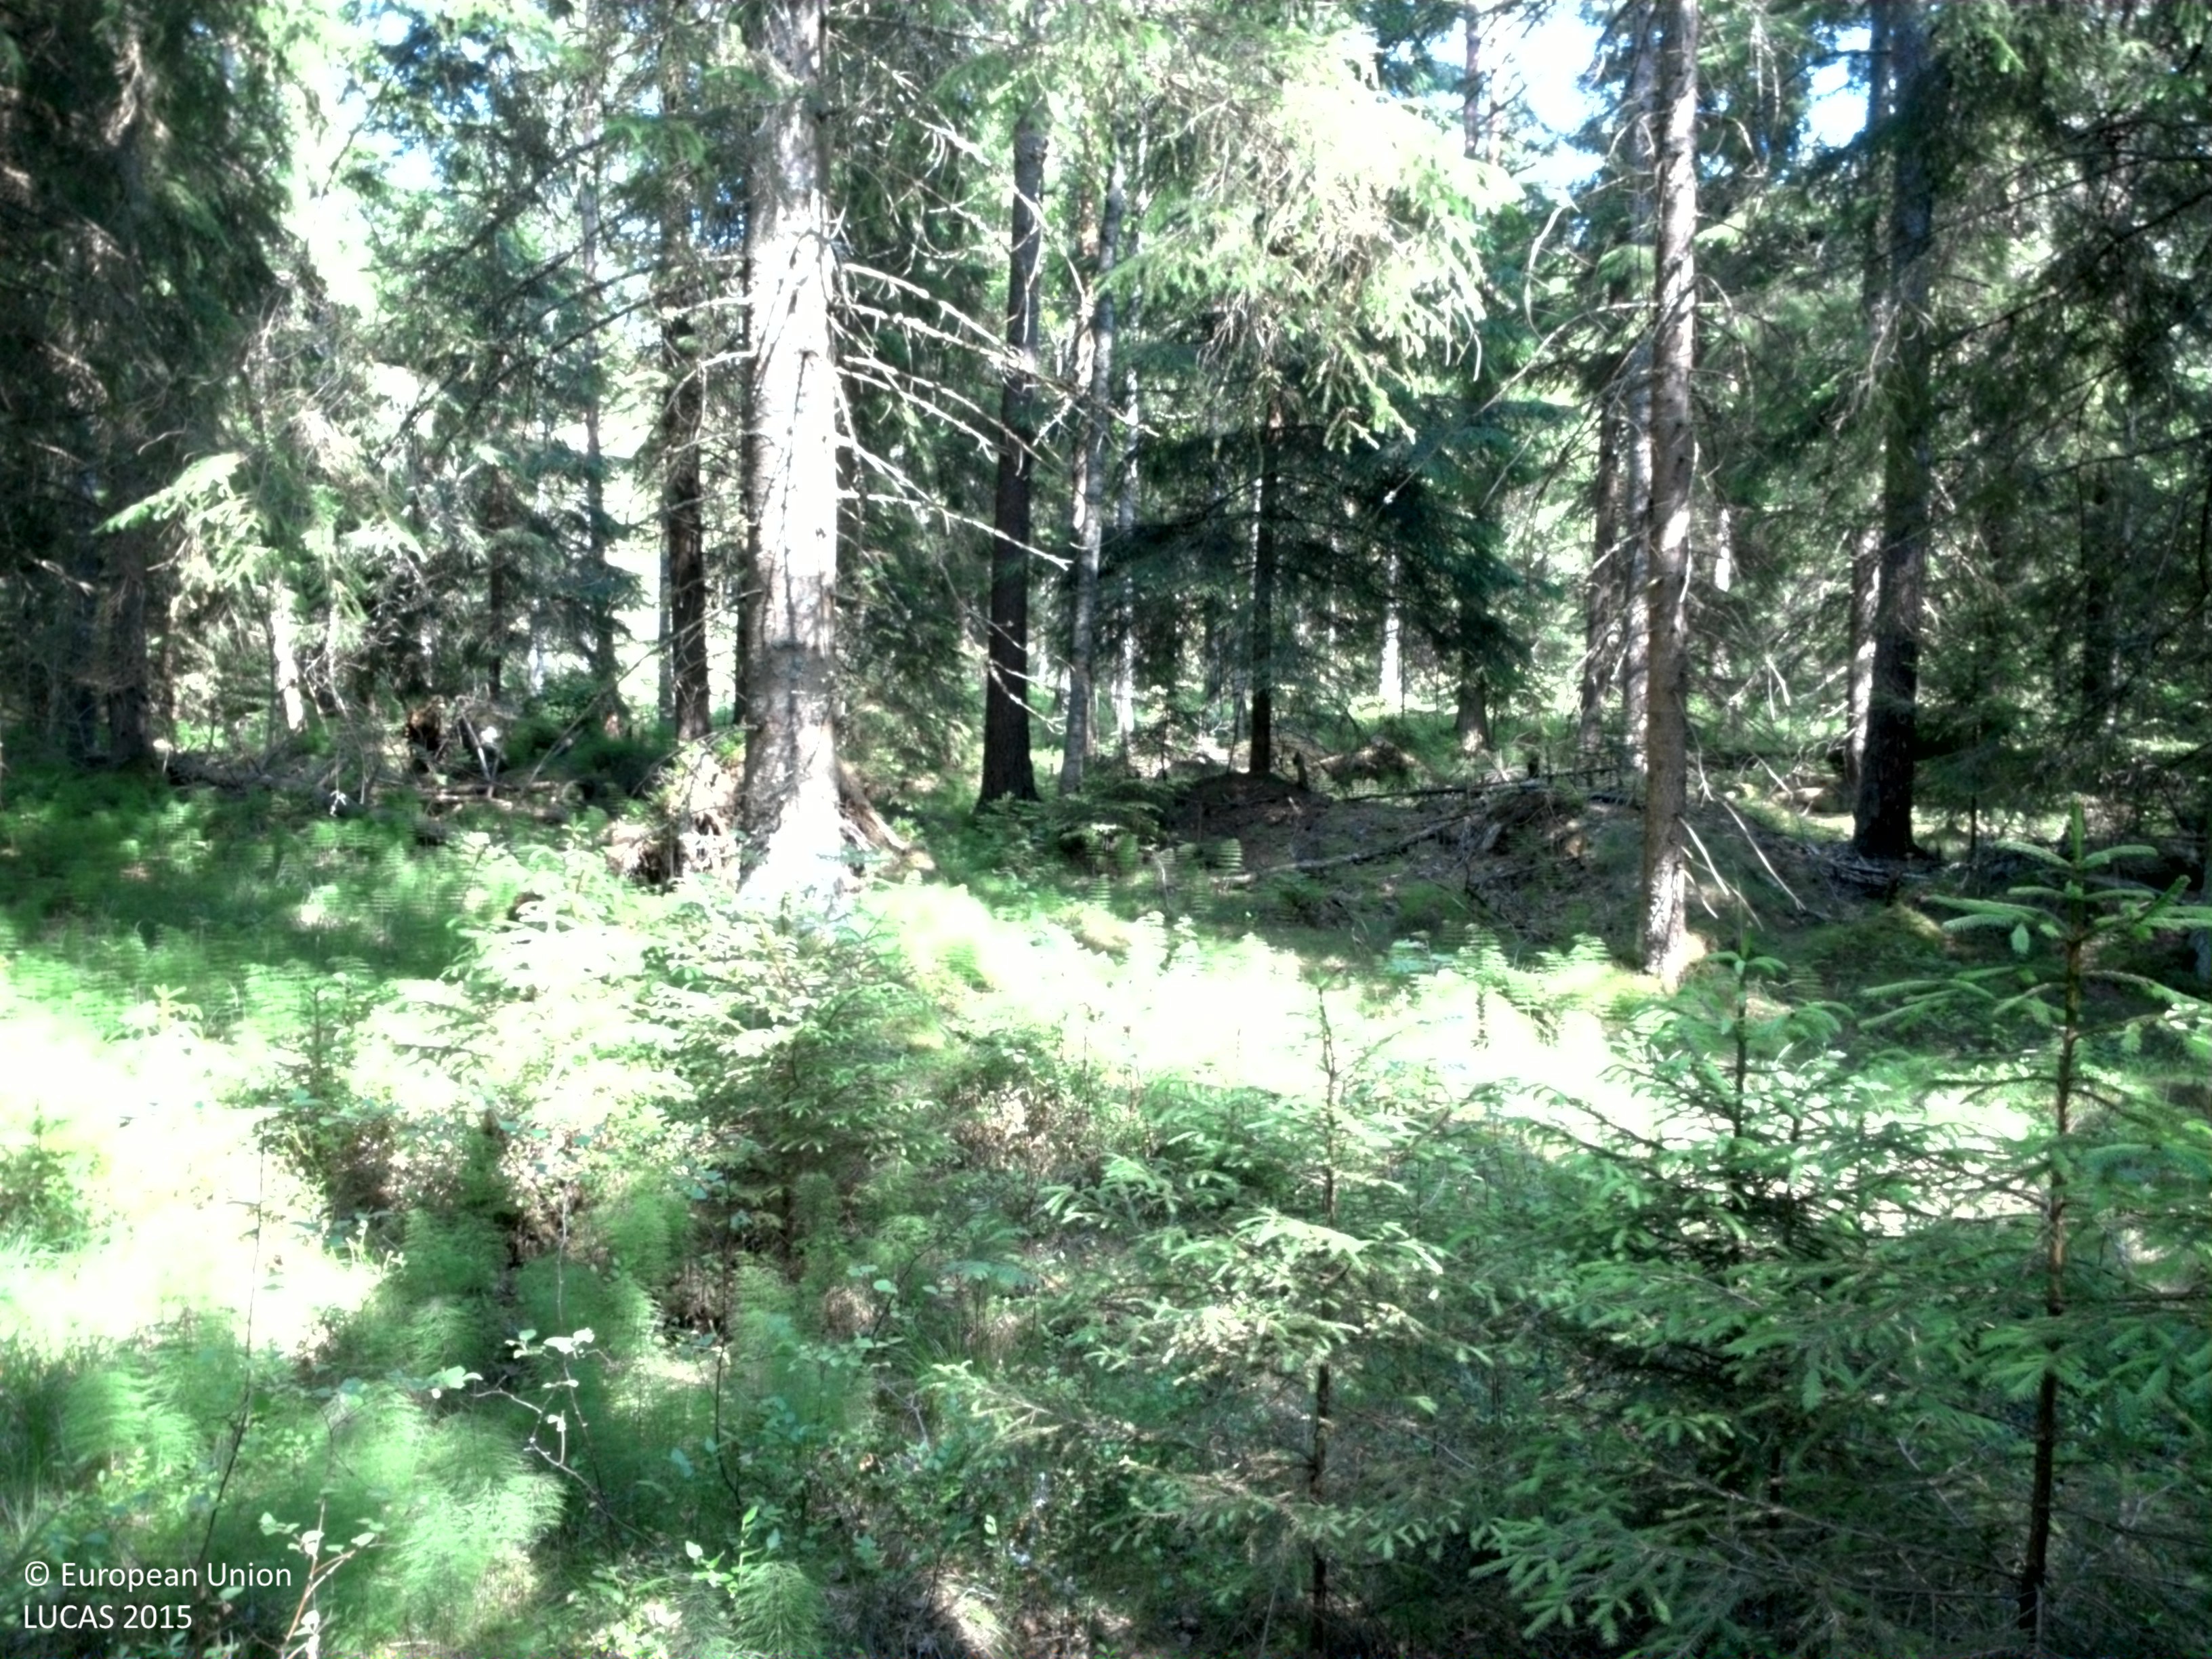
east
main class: Woodland
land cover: Spruce dominated coniferous woodland
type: boreal forest
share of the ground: 50 - 75 %
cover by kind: coniferous forest trees 70 %, shrubs 10 %, lichens and mosses 10 %, broadleaved forest trees 5 %, herbaceous plants 5 %
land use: Forestry
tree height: > 5 m
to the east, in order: Spruce dominated coniferous woodland; Ditches and canals; Pine dominated coniferous woodland; Tracks; Spruce dominated mixed woodland; Spruce dominated coniferous woodland; Grassland without tree/shrub cover; Paved roads, cycling and walking lanes; Ditches and canals; Spruce dominated coniferous woodland; Tracks; Spruce dominated coniferous woodland; Tracks; Ditches and canals; Spruce dominated coniferous woodland; Pine dominated coniferous woodland
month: July
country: SE
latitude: 57.6219
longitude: 13.9299
